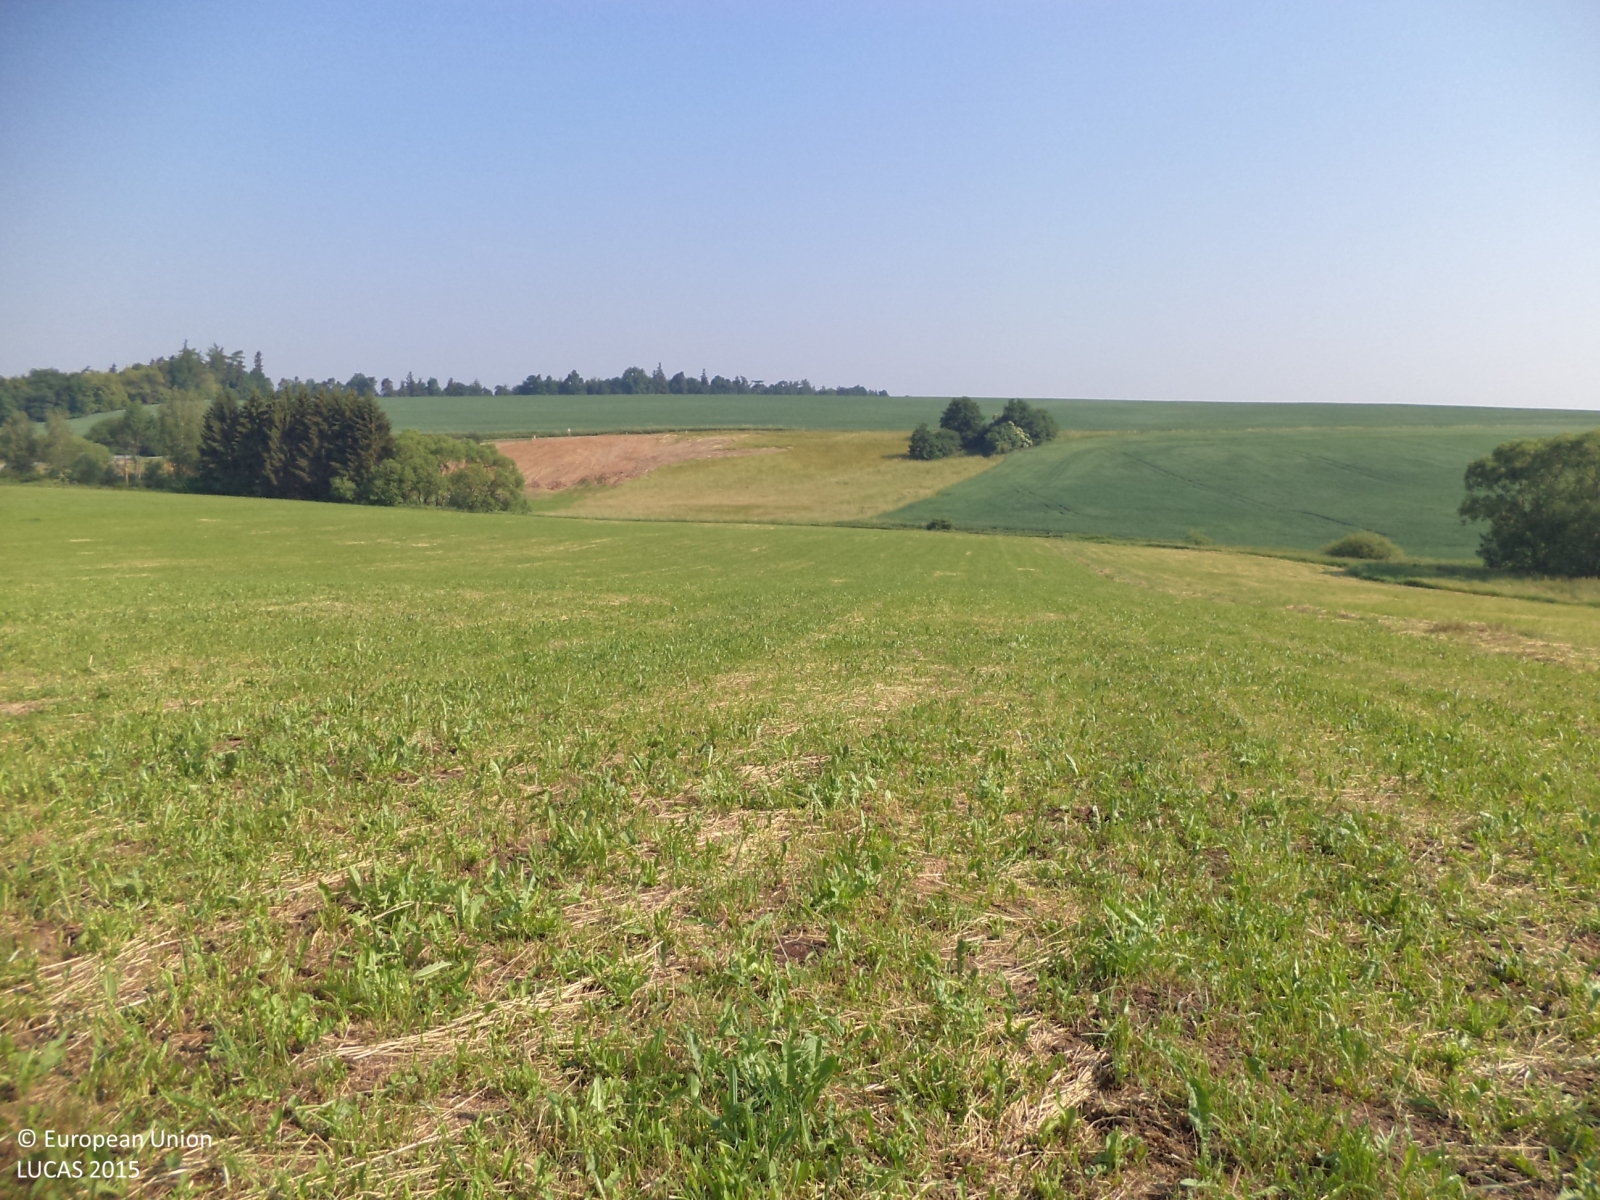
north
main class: Grassland
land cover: Grassland without tree/shrub cover
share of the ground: > 75 %
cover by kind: herbaceous plants 100 %
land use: Agriculture (excluding fallow land and kitchen gardens)
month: June
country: CZ
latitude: 49.2480
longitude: 14.5209
